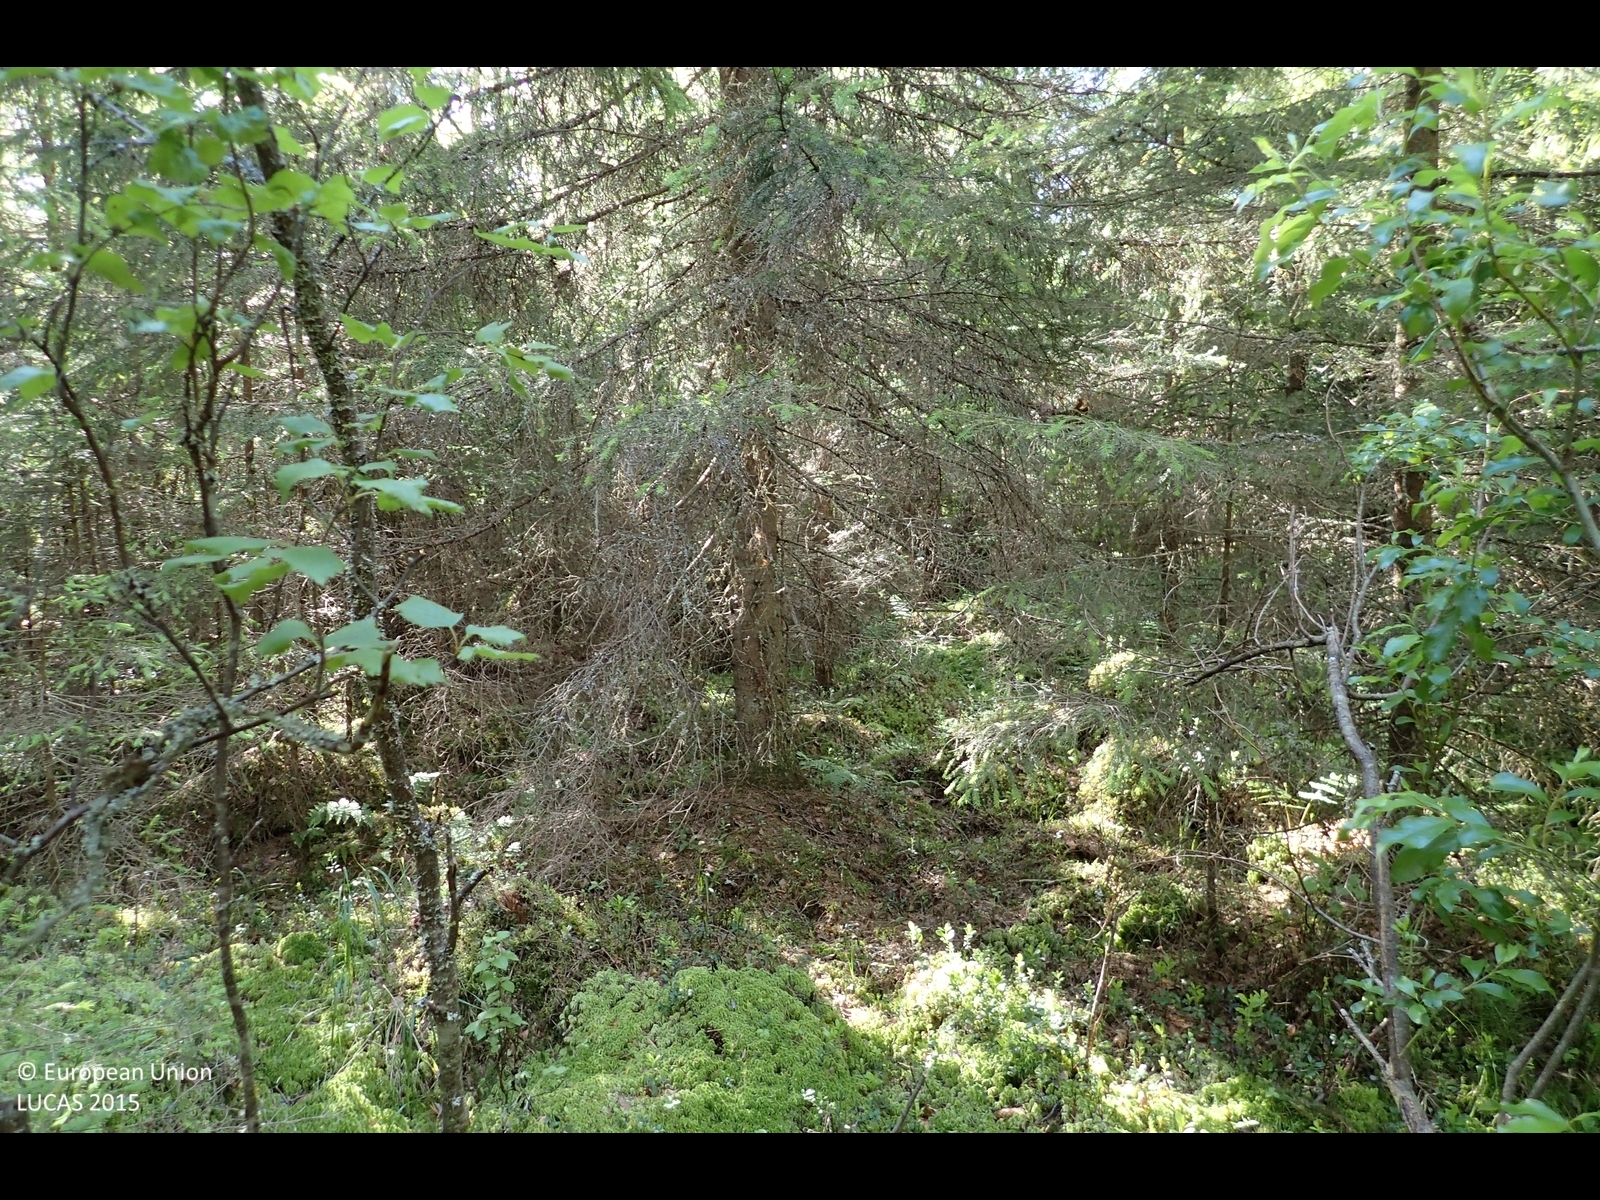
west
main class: Woodland
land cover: Other mixed woodland
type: boreal forest
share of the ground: > 75 %
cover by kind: coniferous forest trees 60 %, broadleaved forest trees 20 %, shrubs 10 %, lichens and mosses 10 %
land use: Forestry
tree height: > 5 m
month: July
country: FI
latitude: 62.6130
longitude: 21.6778
